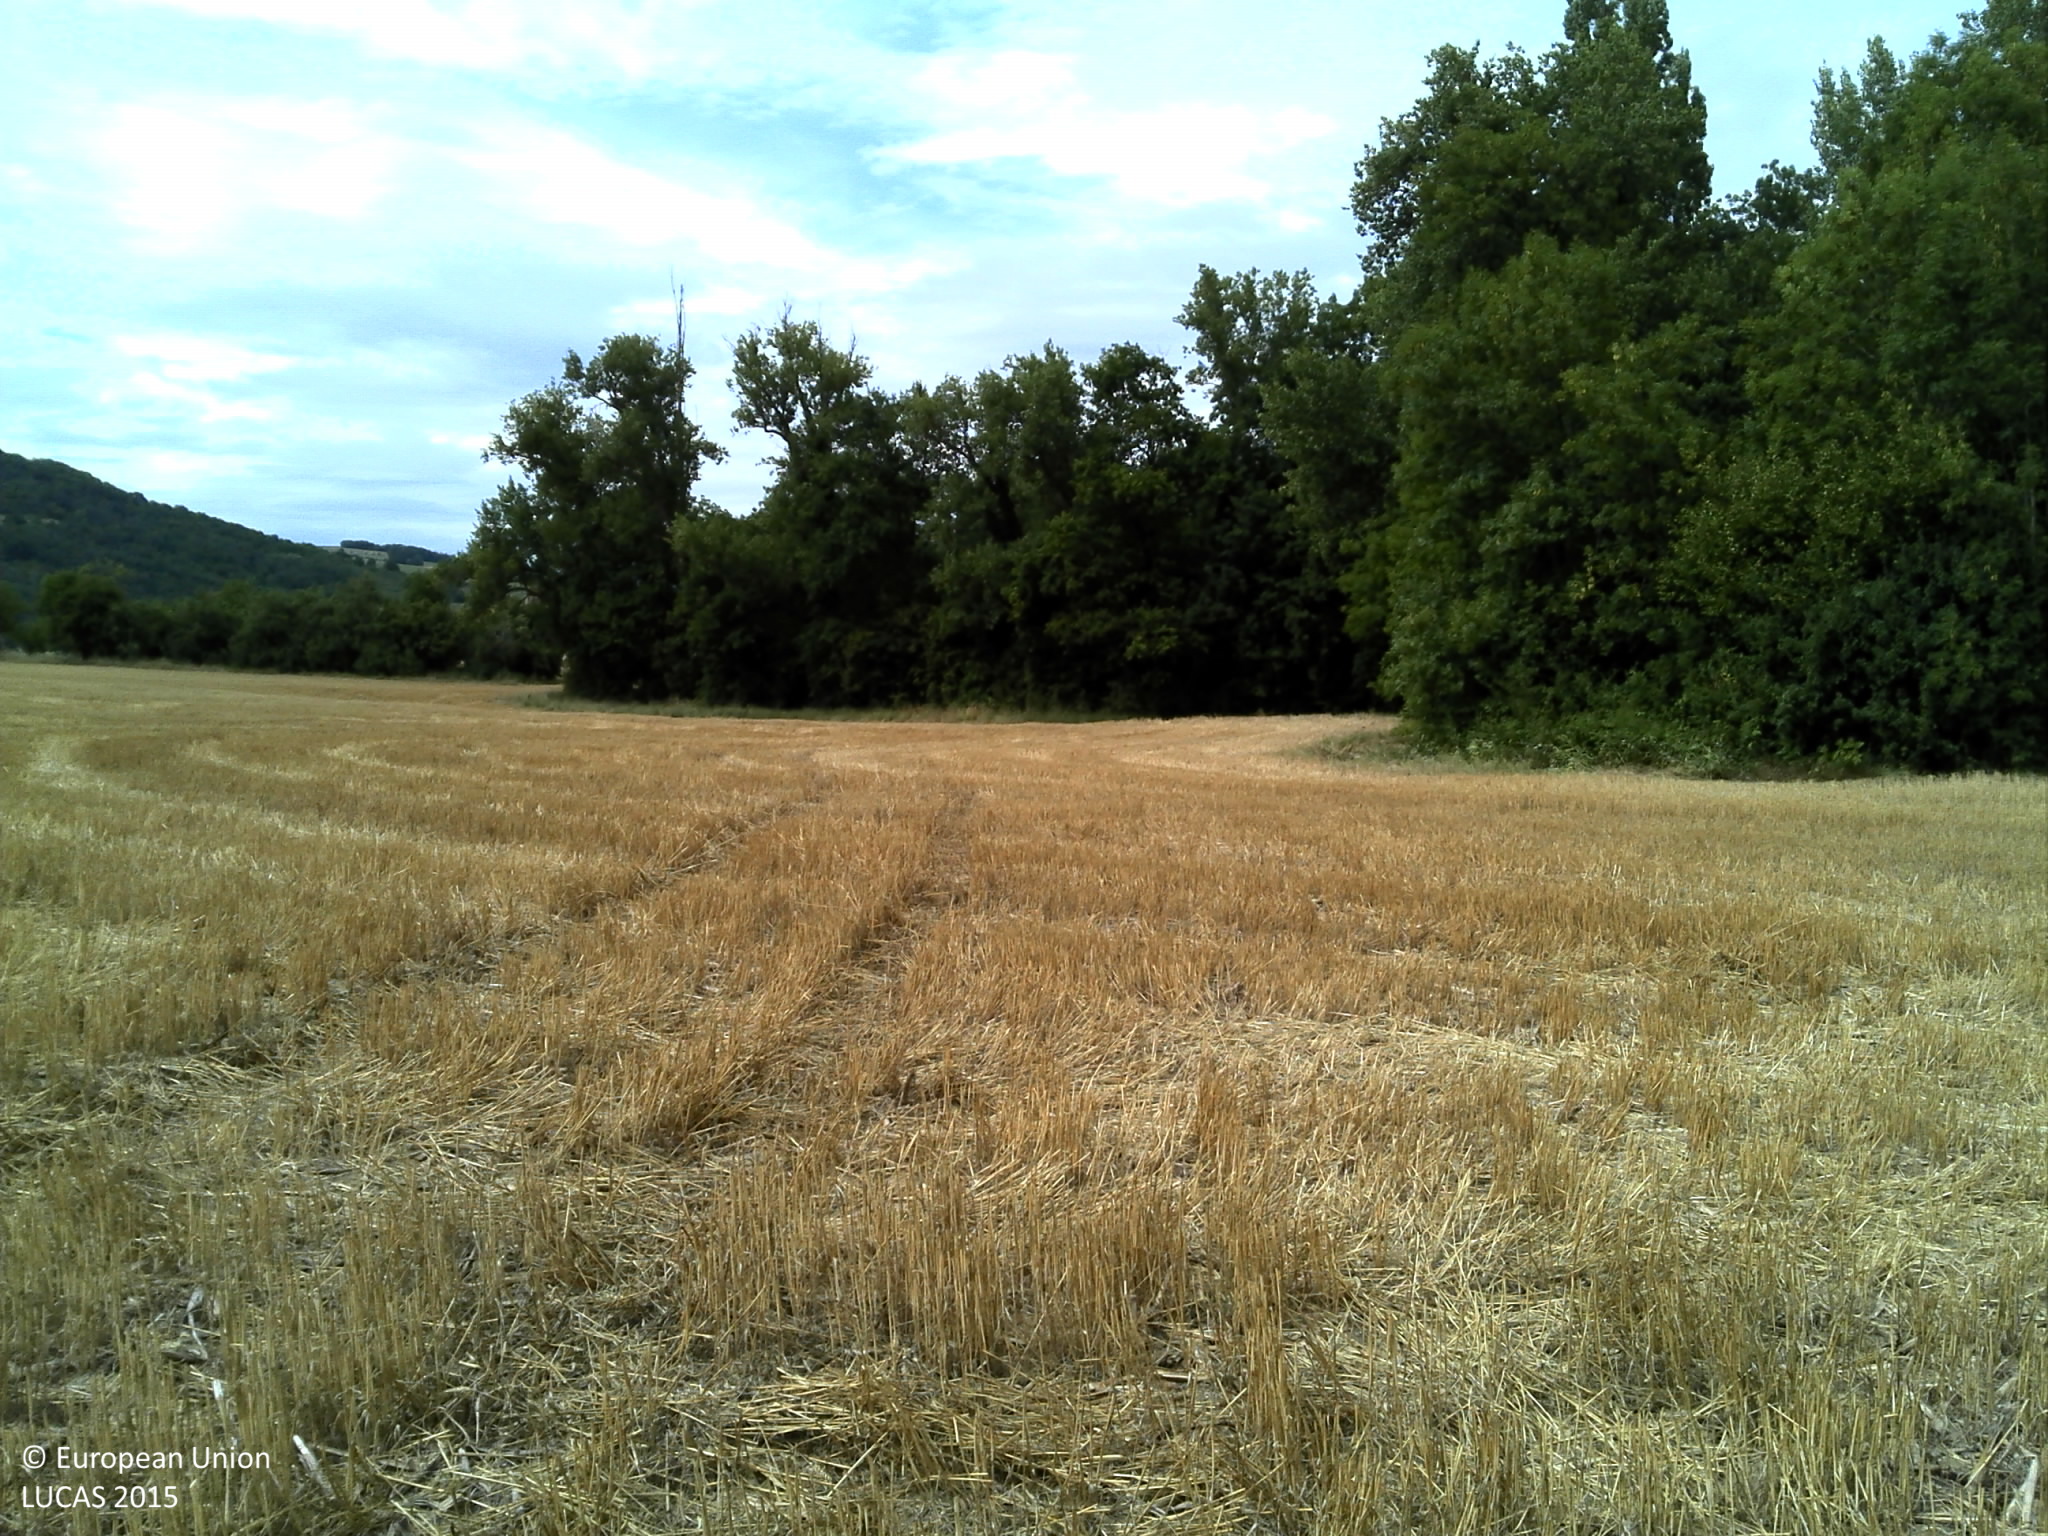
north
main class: Cropland
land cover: Common wheat
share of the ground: > 75 %
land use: Agriculture (excluding fallow land and kitchen gardens)
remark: Harvested field
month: July
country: FR
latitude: 45.7094
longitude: 3.3339
